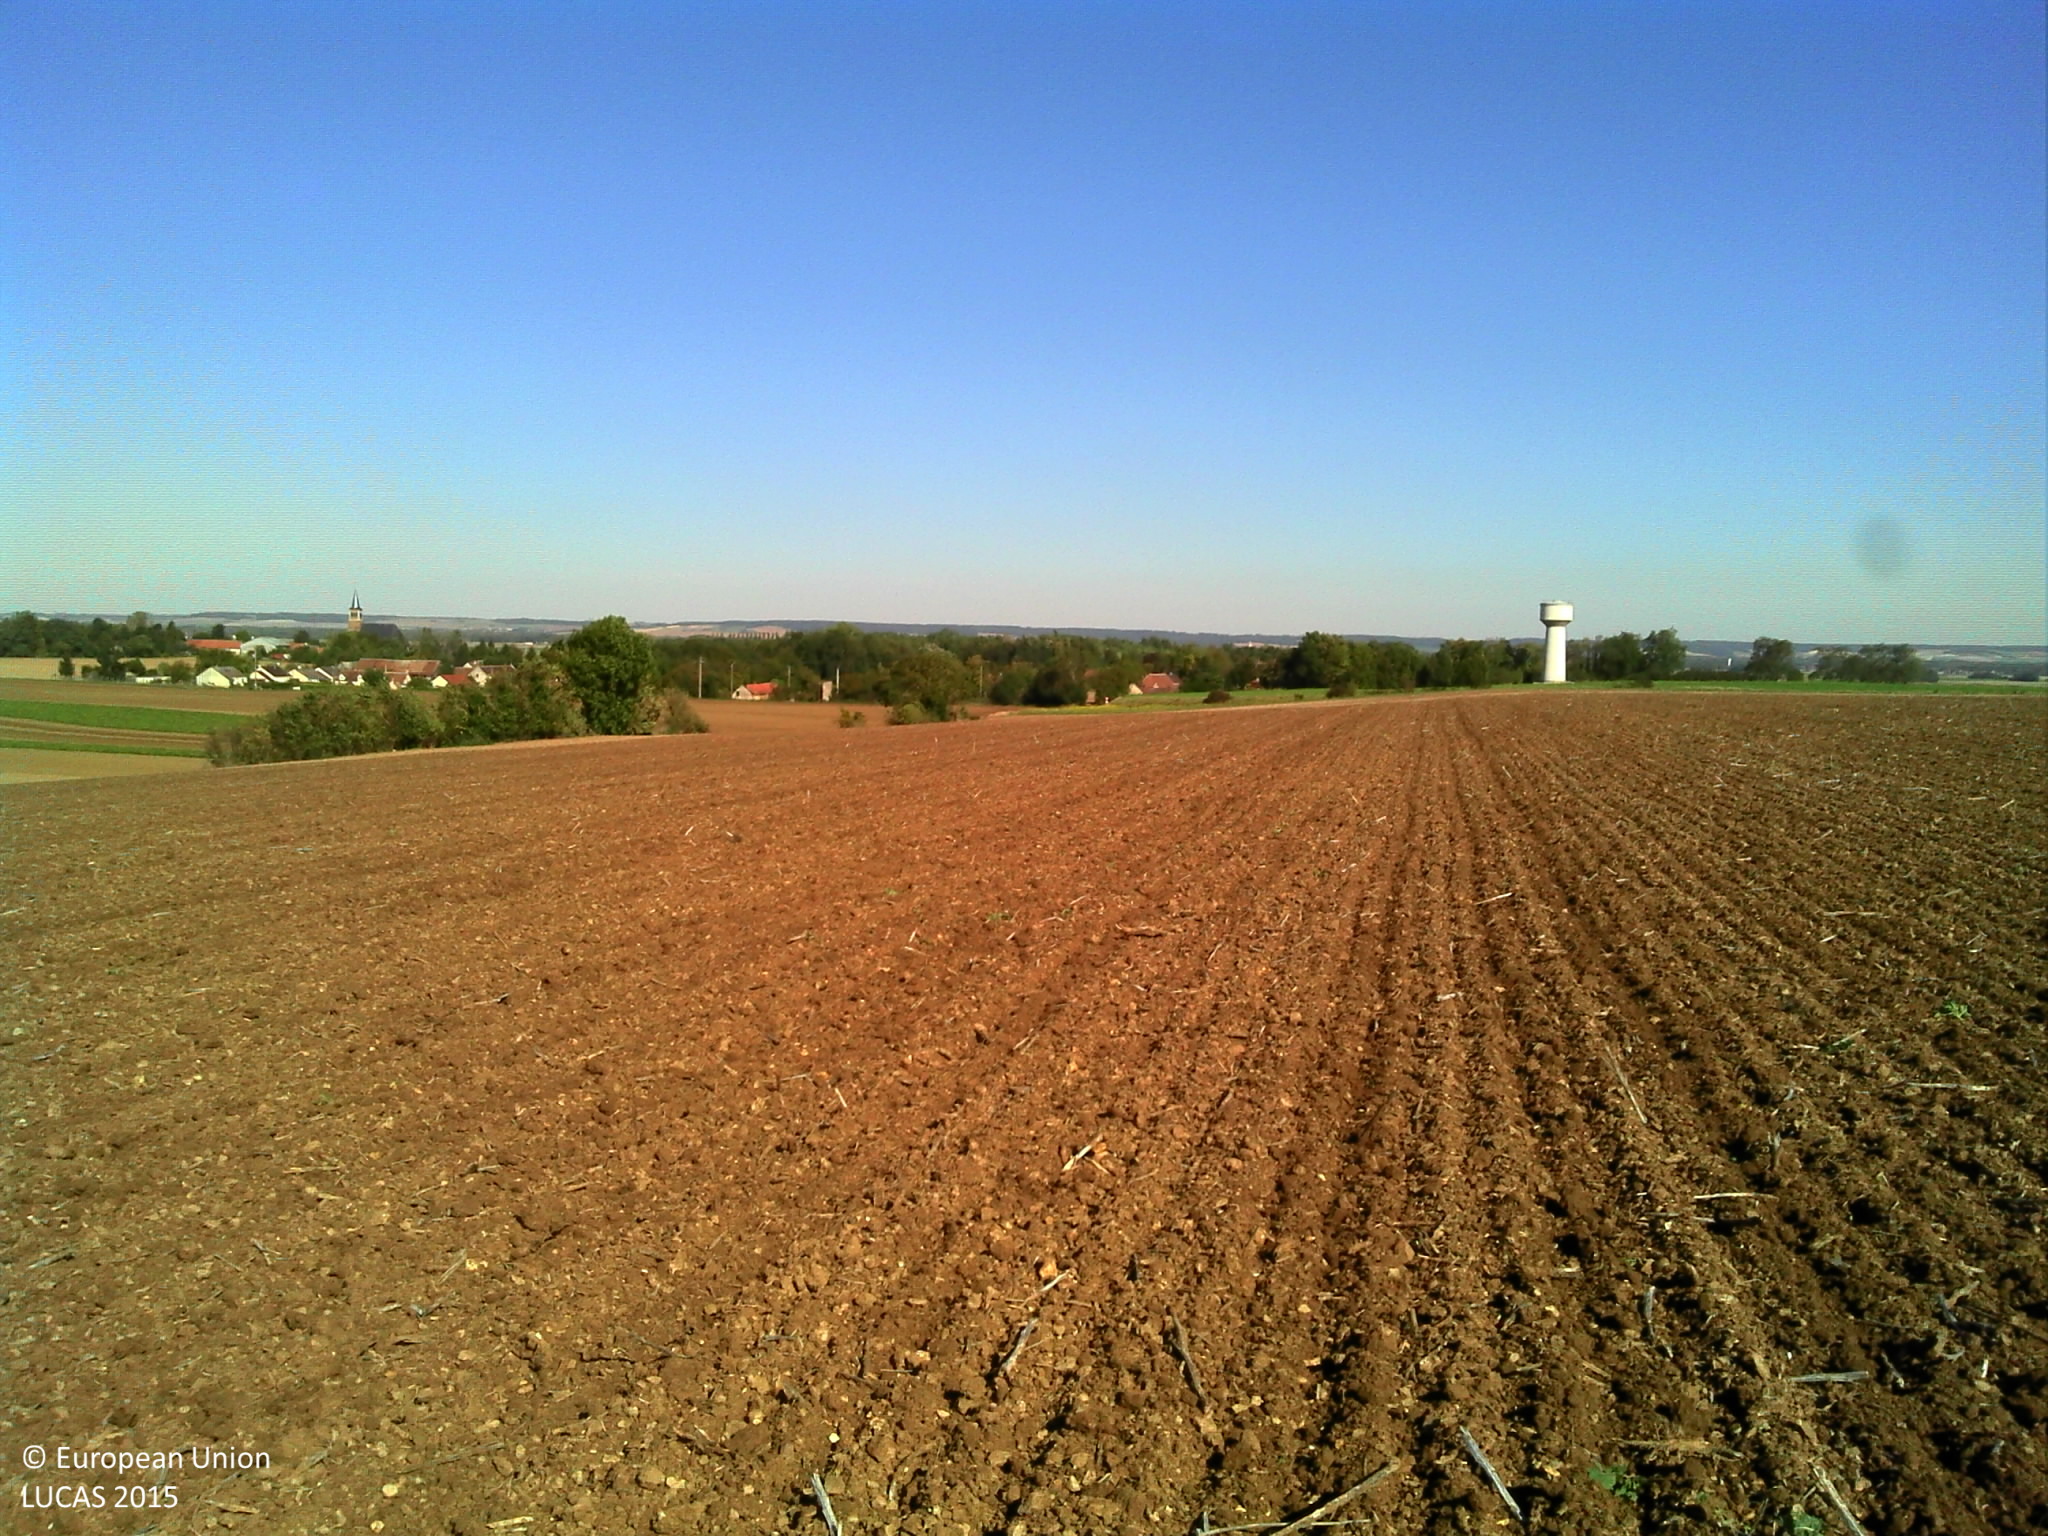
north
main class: Cropland
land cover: Rape and turnip rape
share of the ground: < 10 %
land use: Agriculture (excluding fallow land and kitchen gardens)
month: September
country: FR
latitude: 48.4025
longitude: 3.3613
